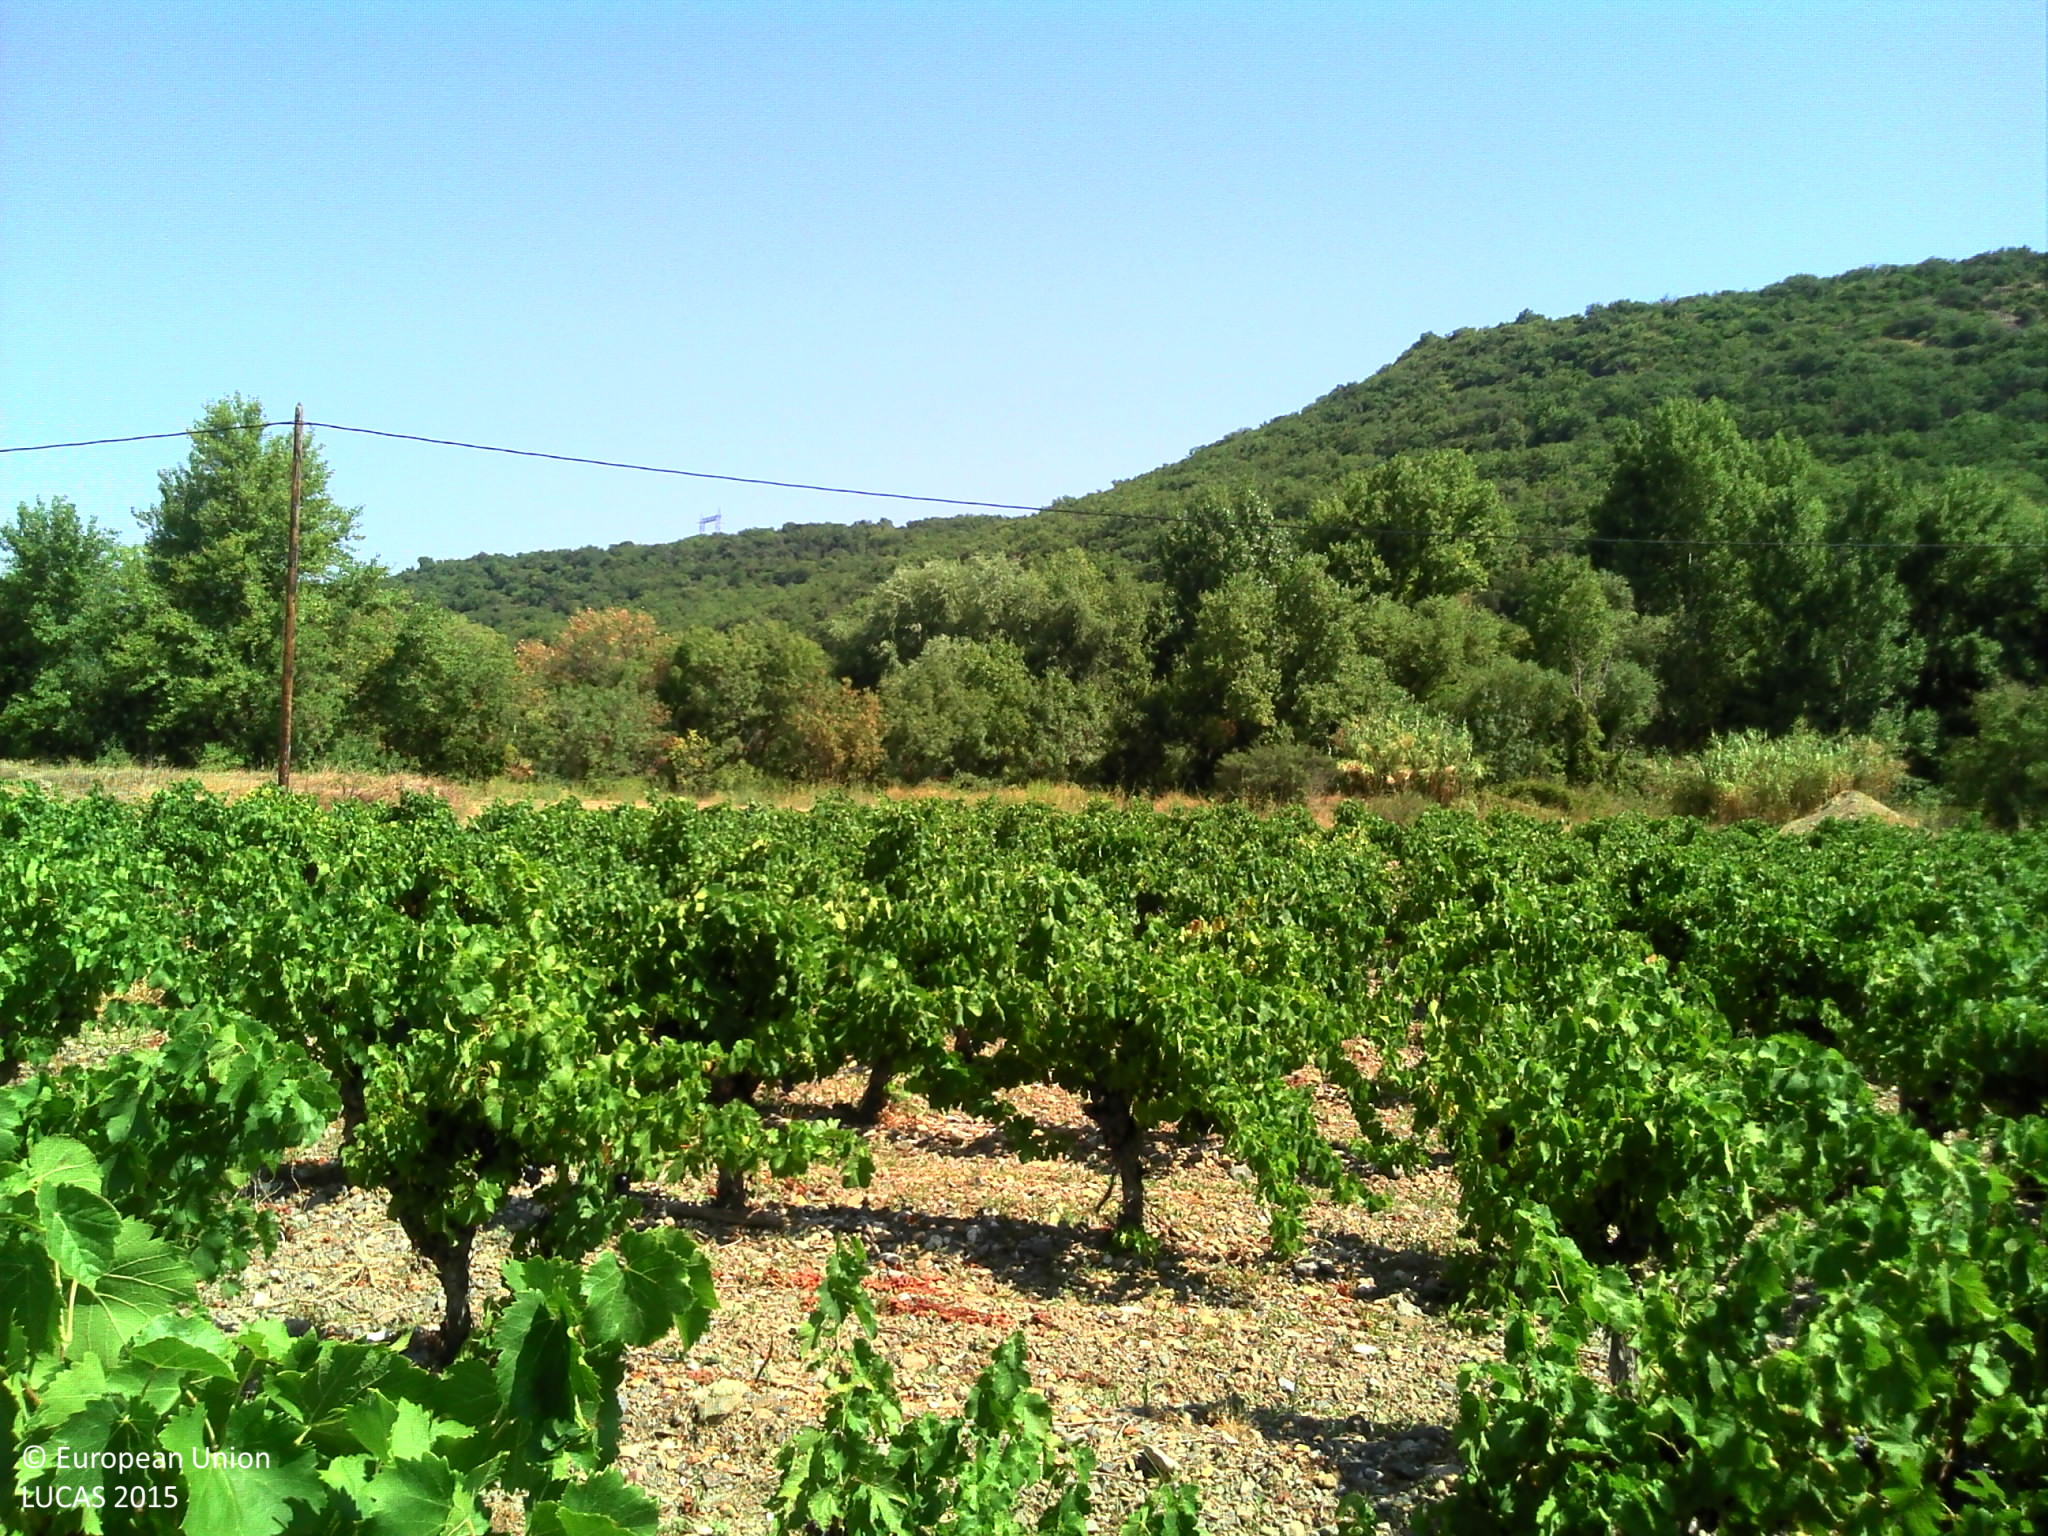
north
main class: Cropland
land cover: Vineyards
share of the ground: 10 - 25 %
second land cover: Other bare soil
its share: > 75 %
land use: Agriculture (excluding fallow land and kitchen gardens)
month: August
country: FR
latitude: 43.5424
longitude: 3.3876
